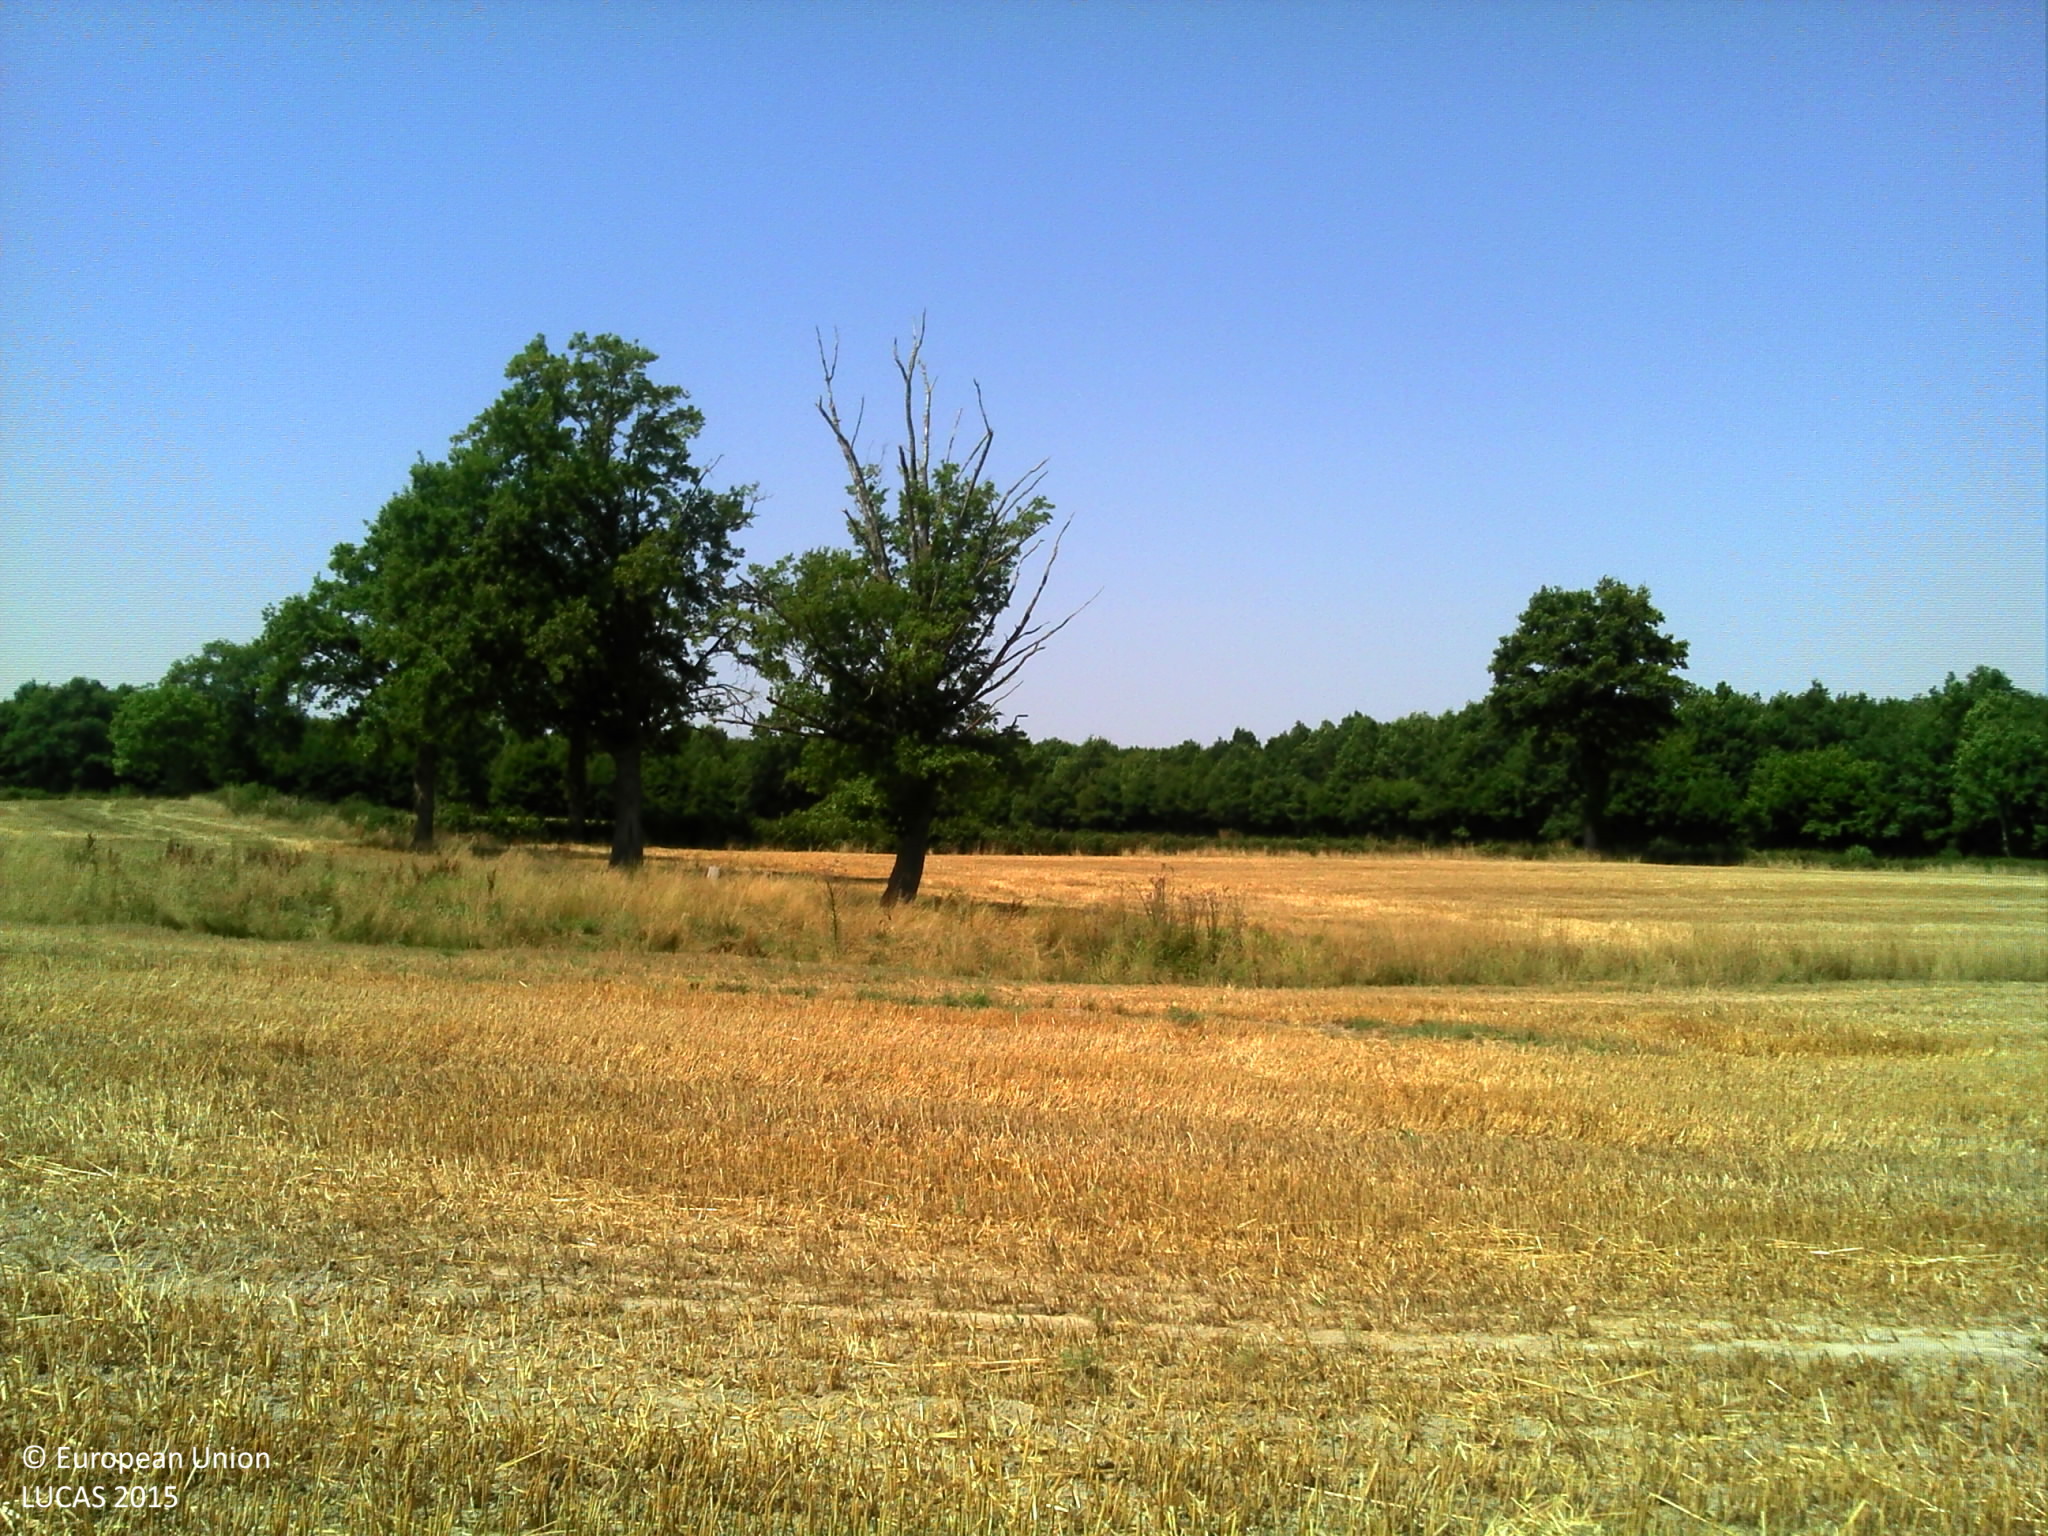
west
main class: Cropland
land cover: Barley
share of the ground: > 75 %
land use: Agriculture (excluding fallow land and kitchen gardens)
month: July
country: FR
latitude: 46.5013
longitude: 2.9997
